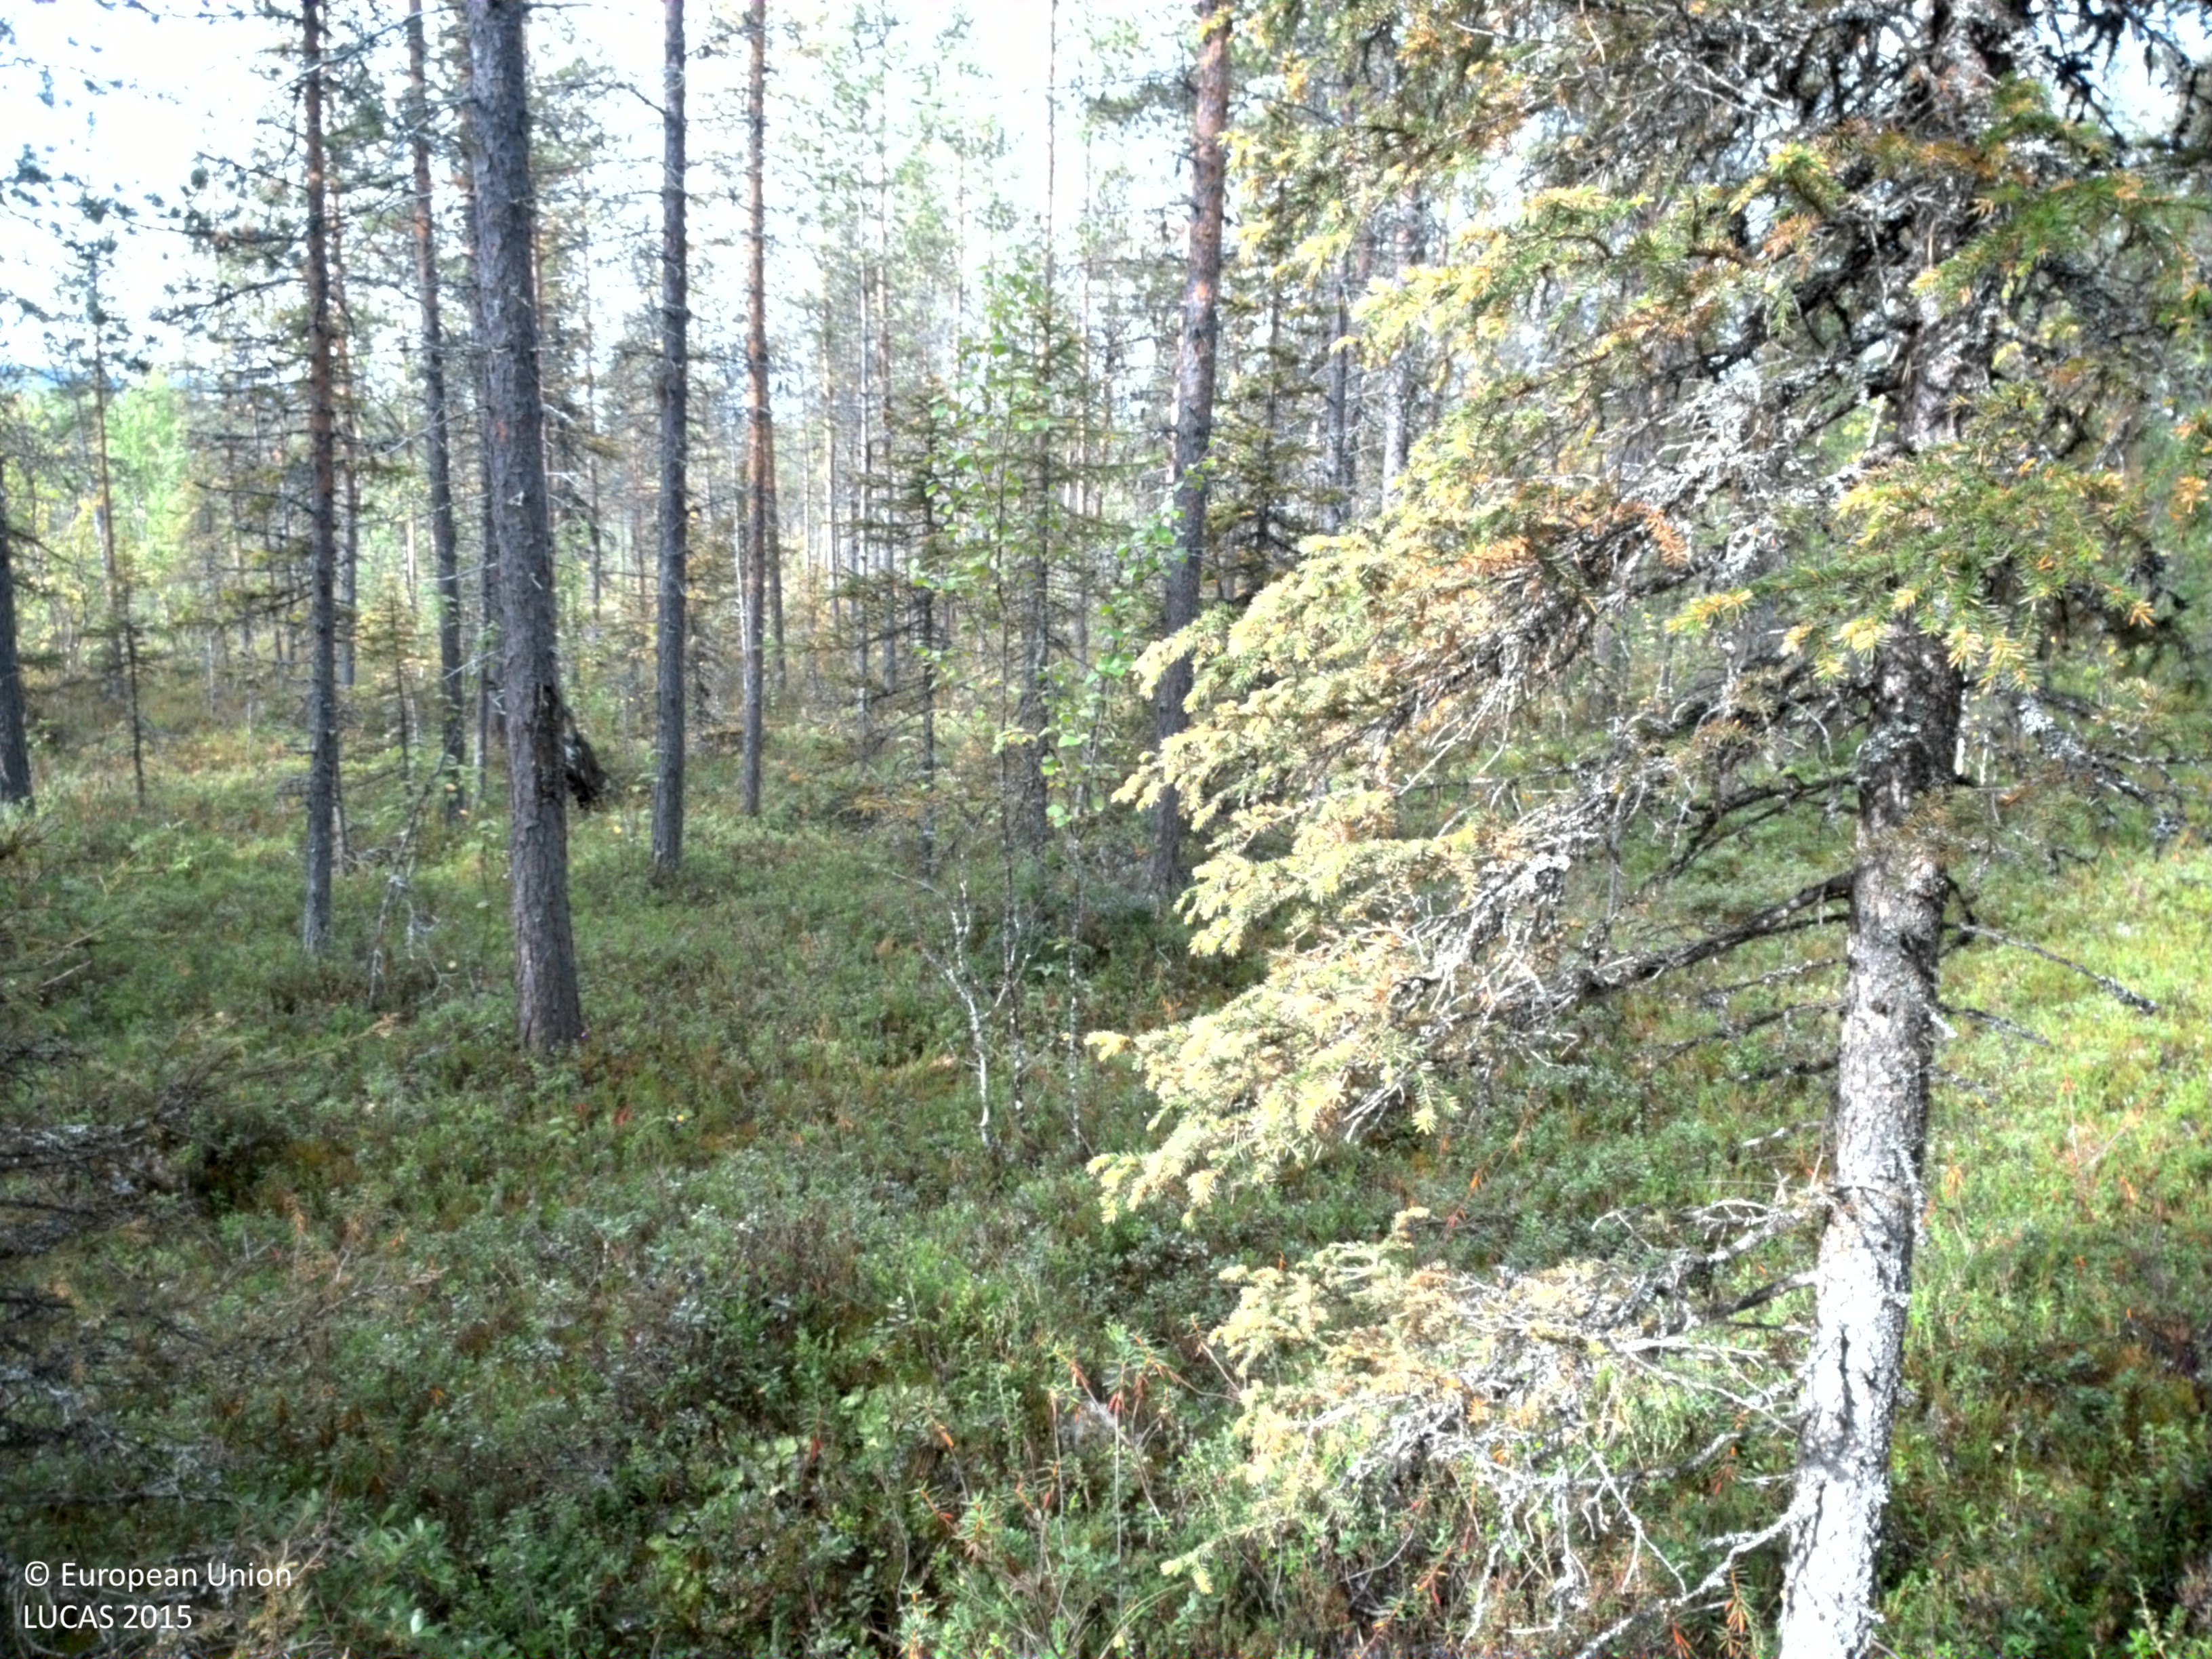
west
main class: Woodland
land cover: Pine dominated coniferous woodland
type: boreal forest
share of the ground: 25 - 50 %
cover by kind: shrubs 65 %, coniferous forest trees 30 %, broadleaved forest trees 5 %
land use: Forestry
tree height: > 5 m
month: August
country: SE
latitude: 66.5855
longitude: 19.6264
